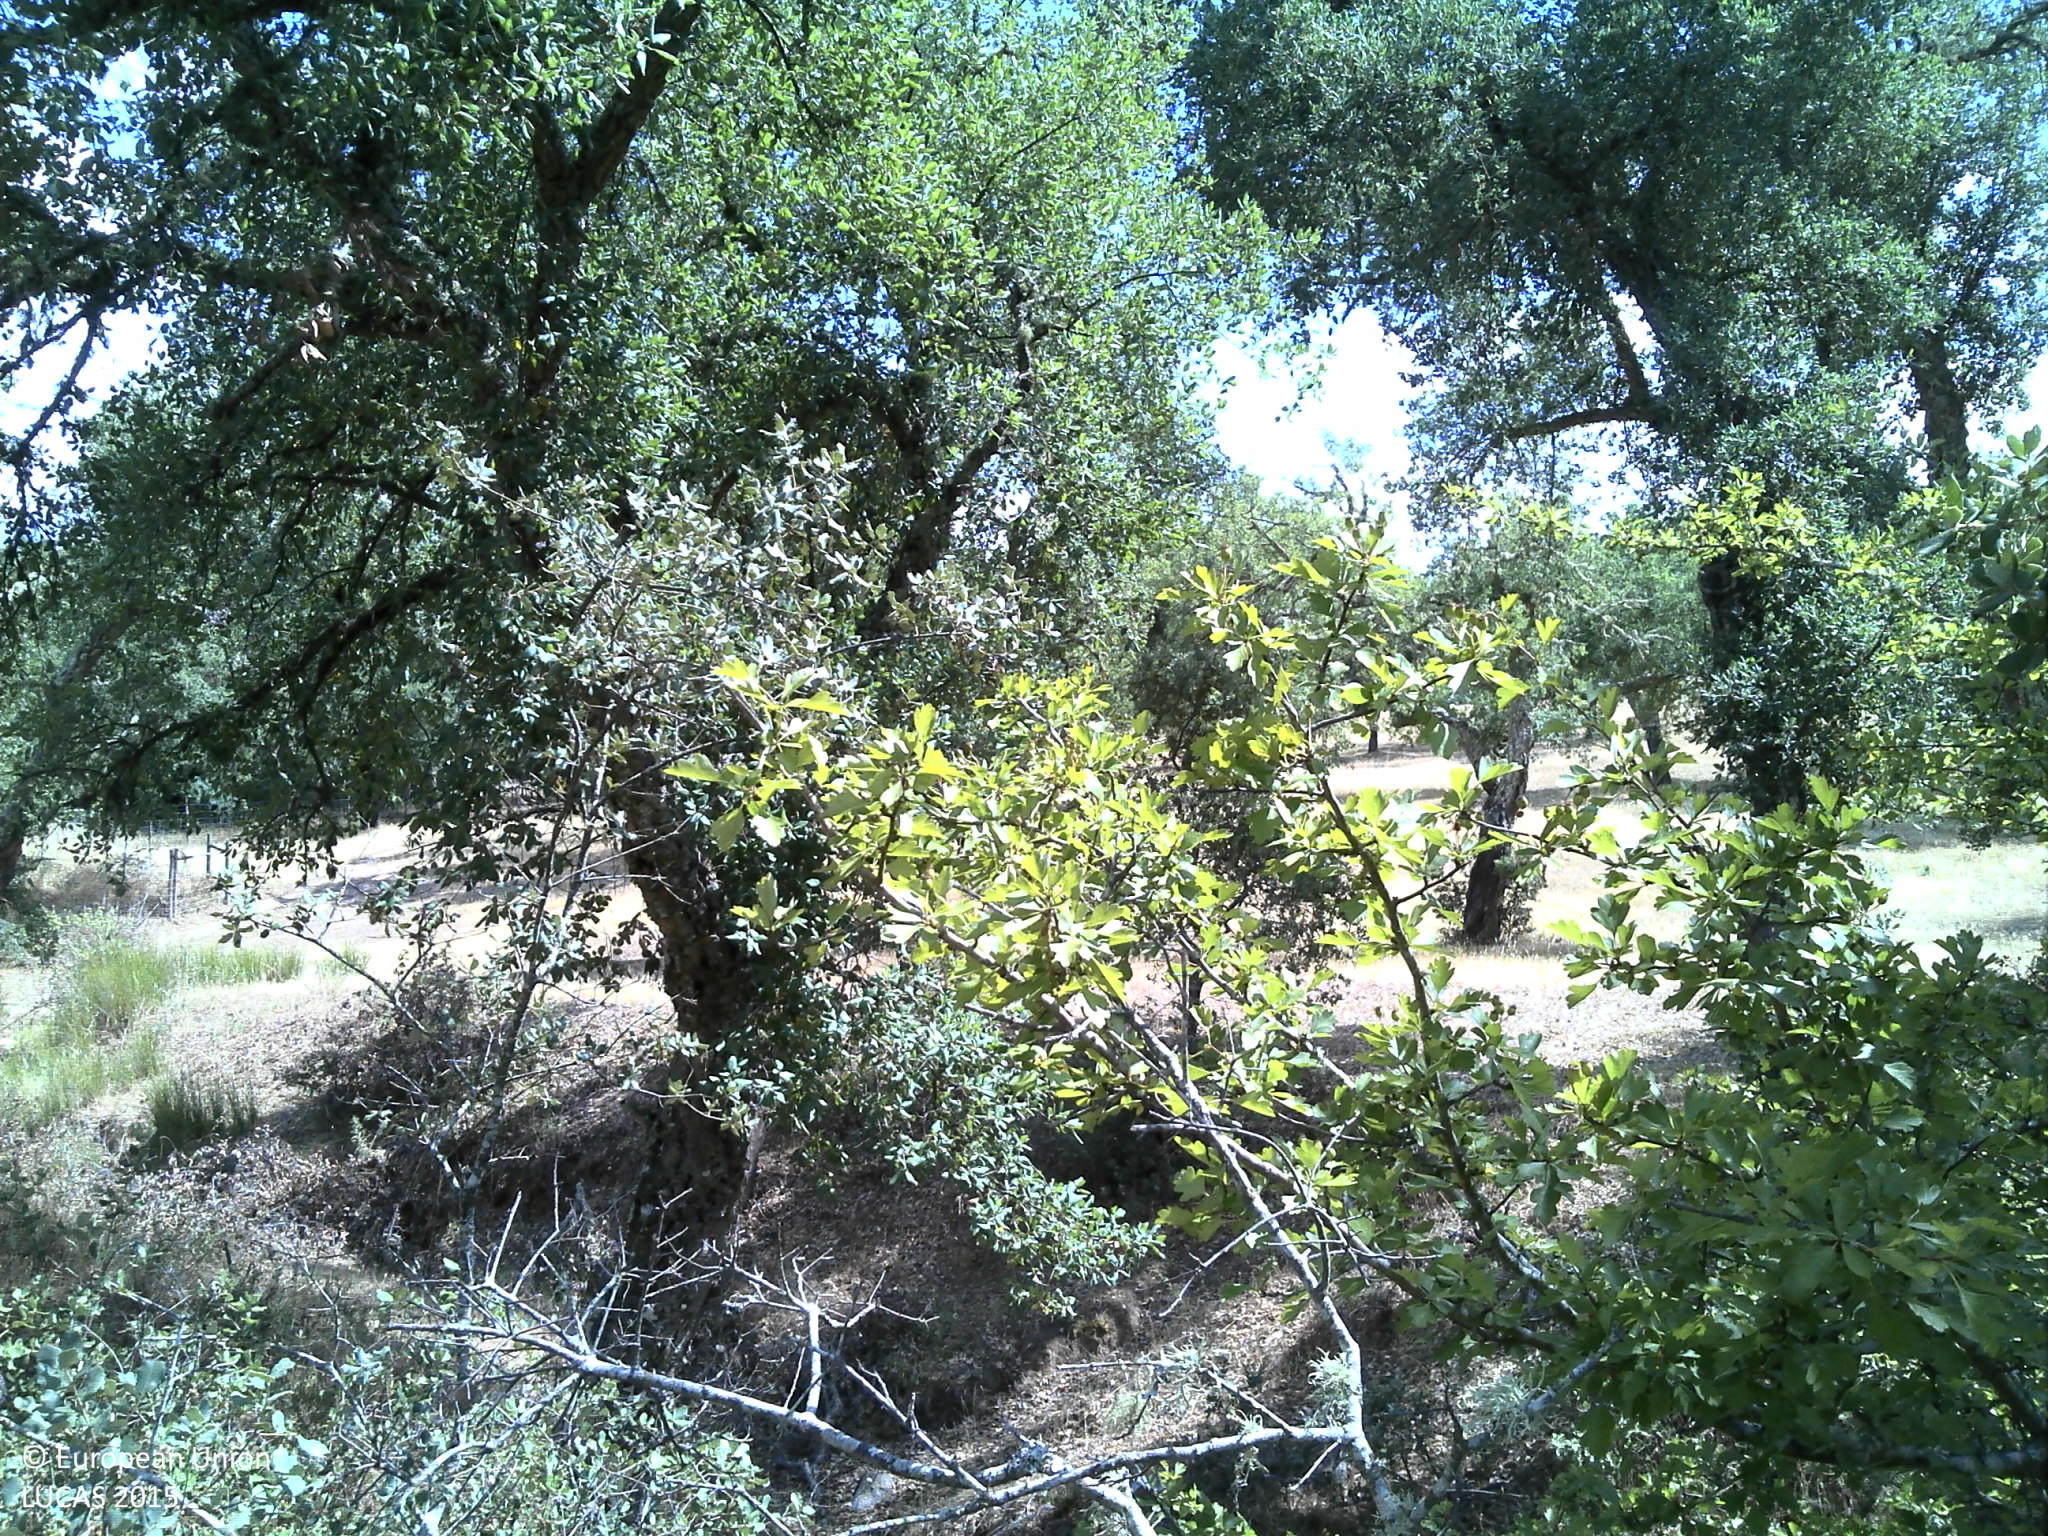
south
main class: Woodland
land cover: Broadleaved woodland
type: broadleaved evergreen forest
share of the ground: > 75 %
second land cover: Grassland without tree/shrub cover
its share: 10 - 25 %
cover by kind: broadleaved forest trees 80 %, herbaceous plants 10 %, unconsolidated bare surface 10 %
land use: Forestry
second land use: Agriculture (excluding fallow land and kitchen gardens)
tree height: > 5 m
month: June
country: PT
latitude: 38.5726
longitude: -8.0754
